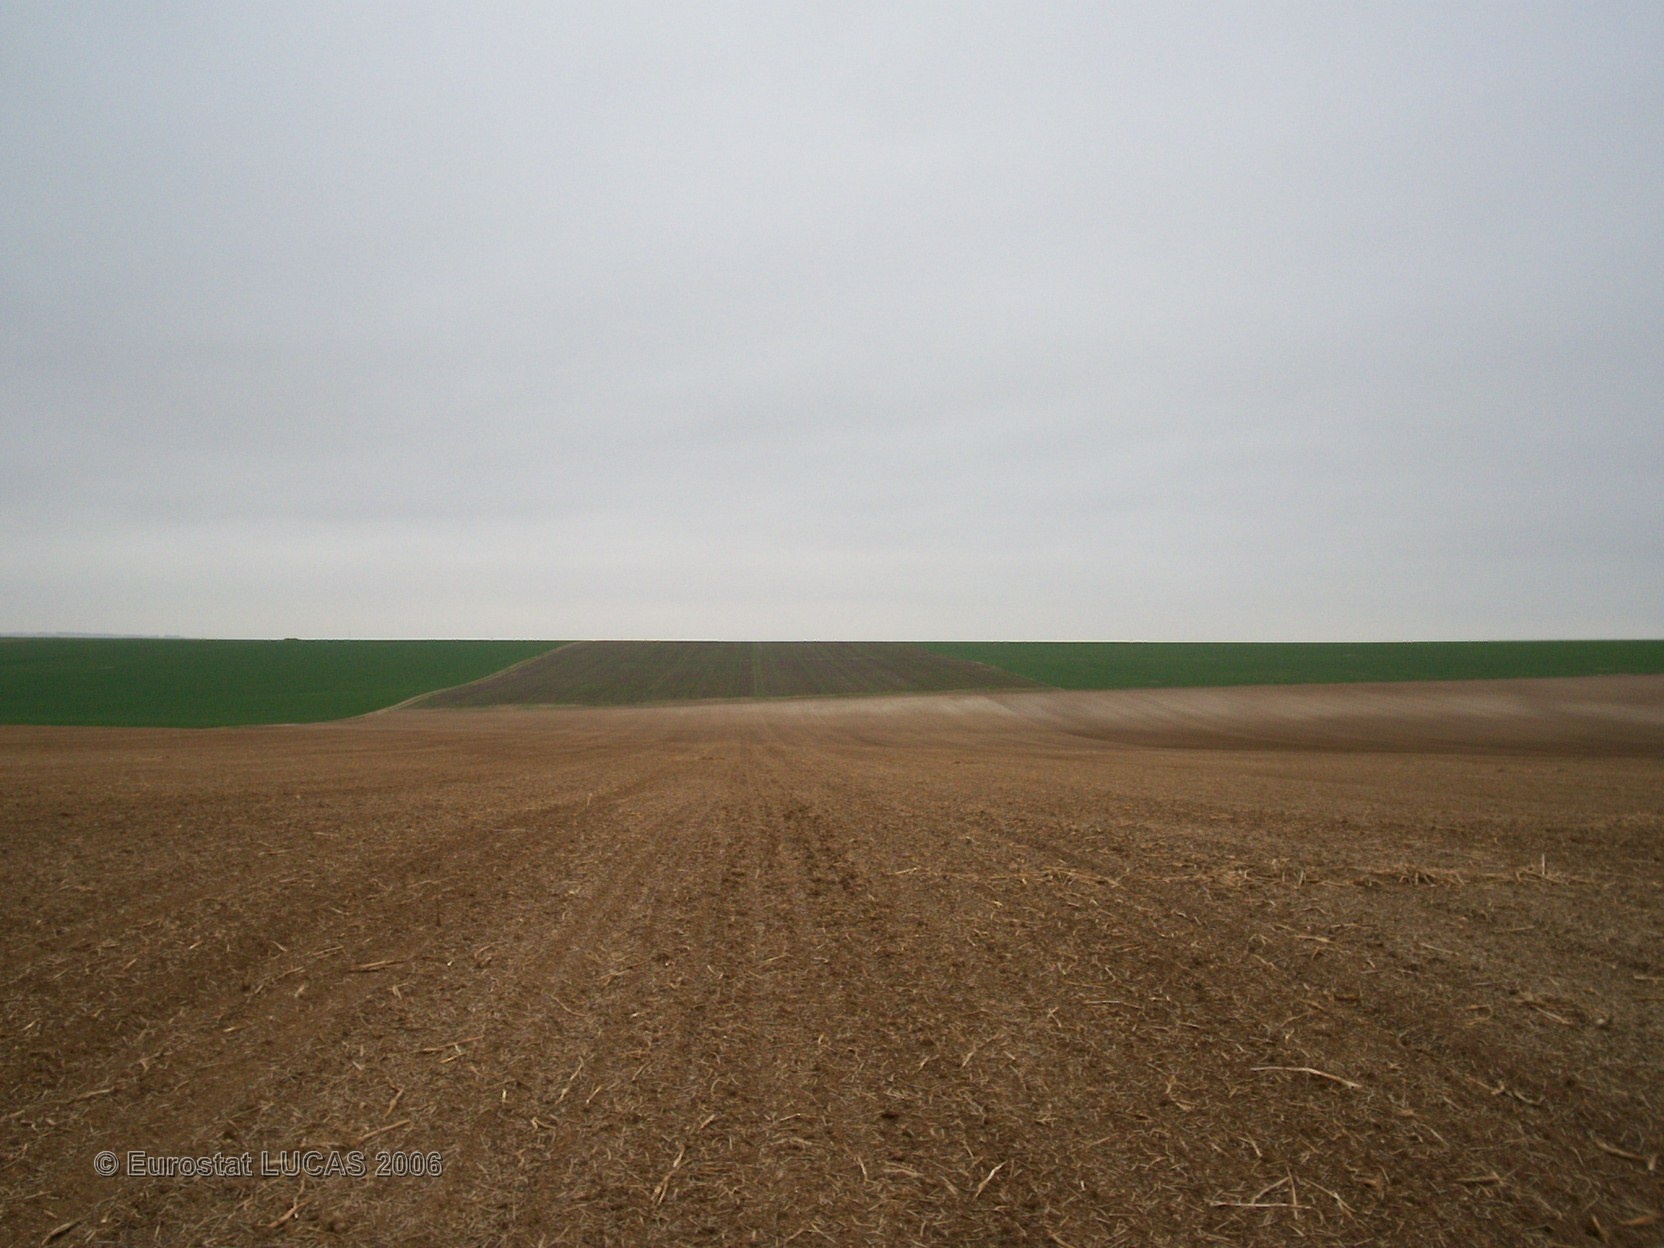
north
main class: Cropland
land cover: Sugar beet
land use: Agriculture (excluding fallow land and kitchen gardens)
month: April
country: FR
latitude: 49.2729
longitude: 4.4298
